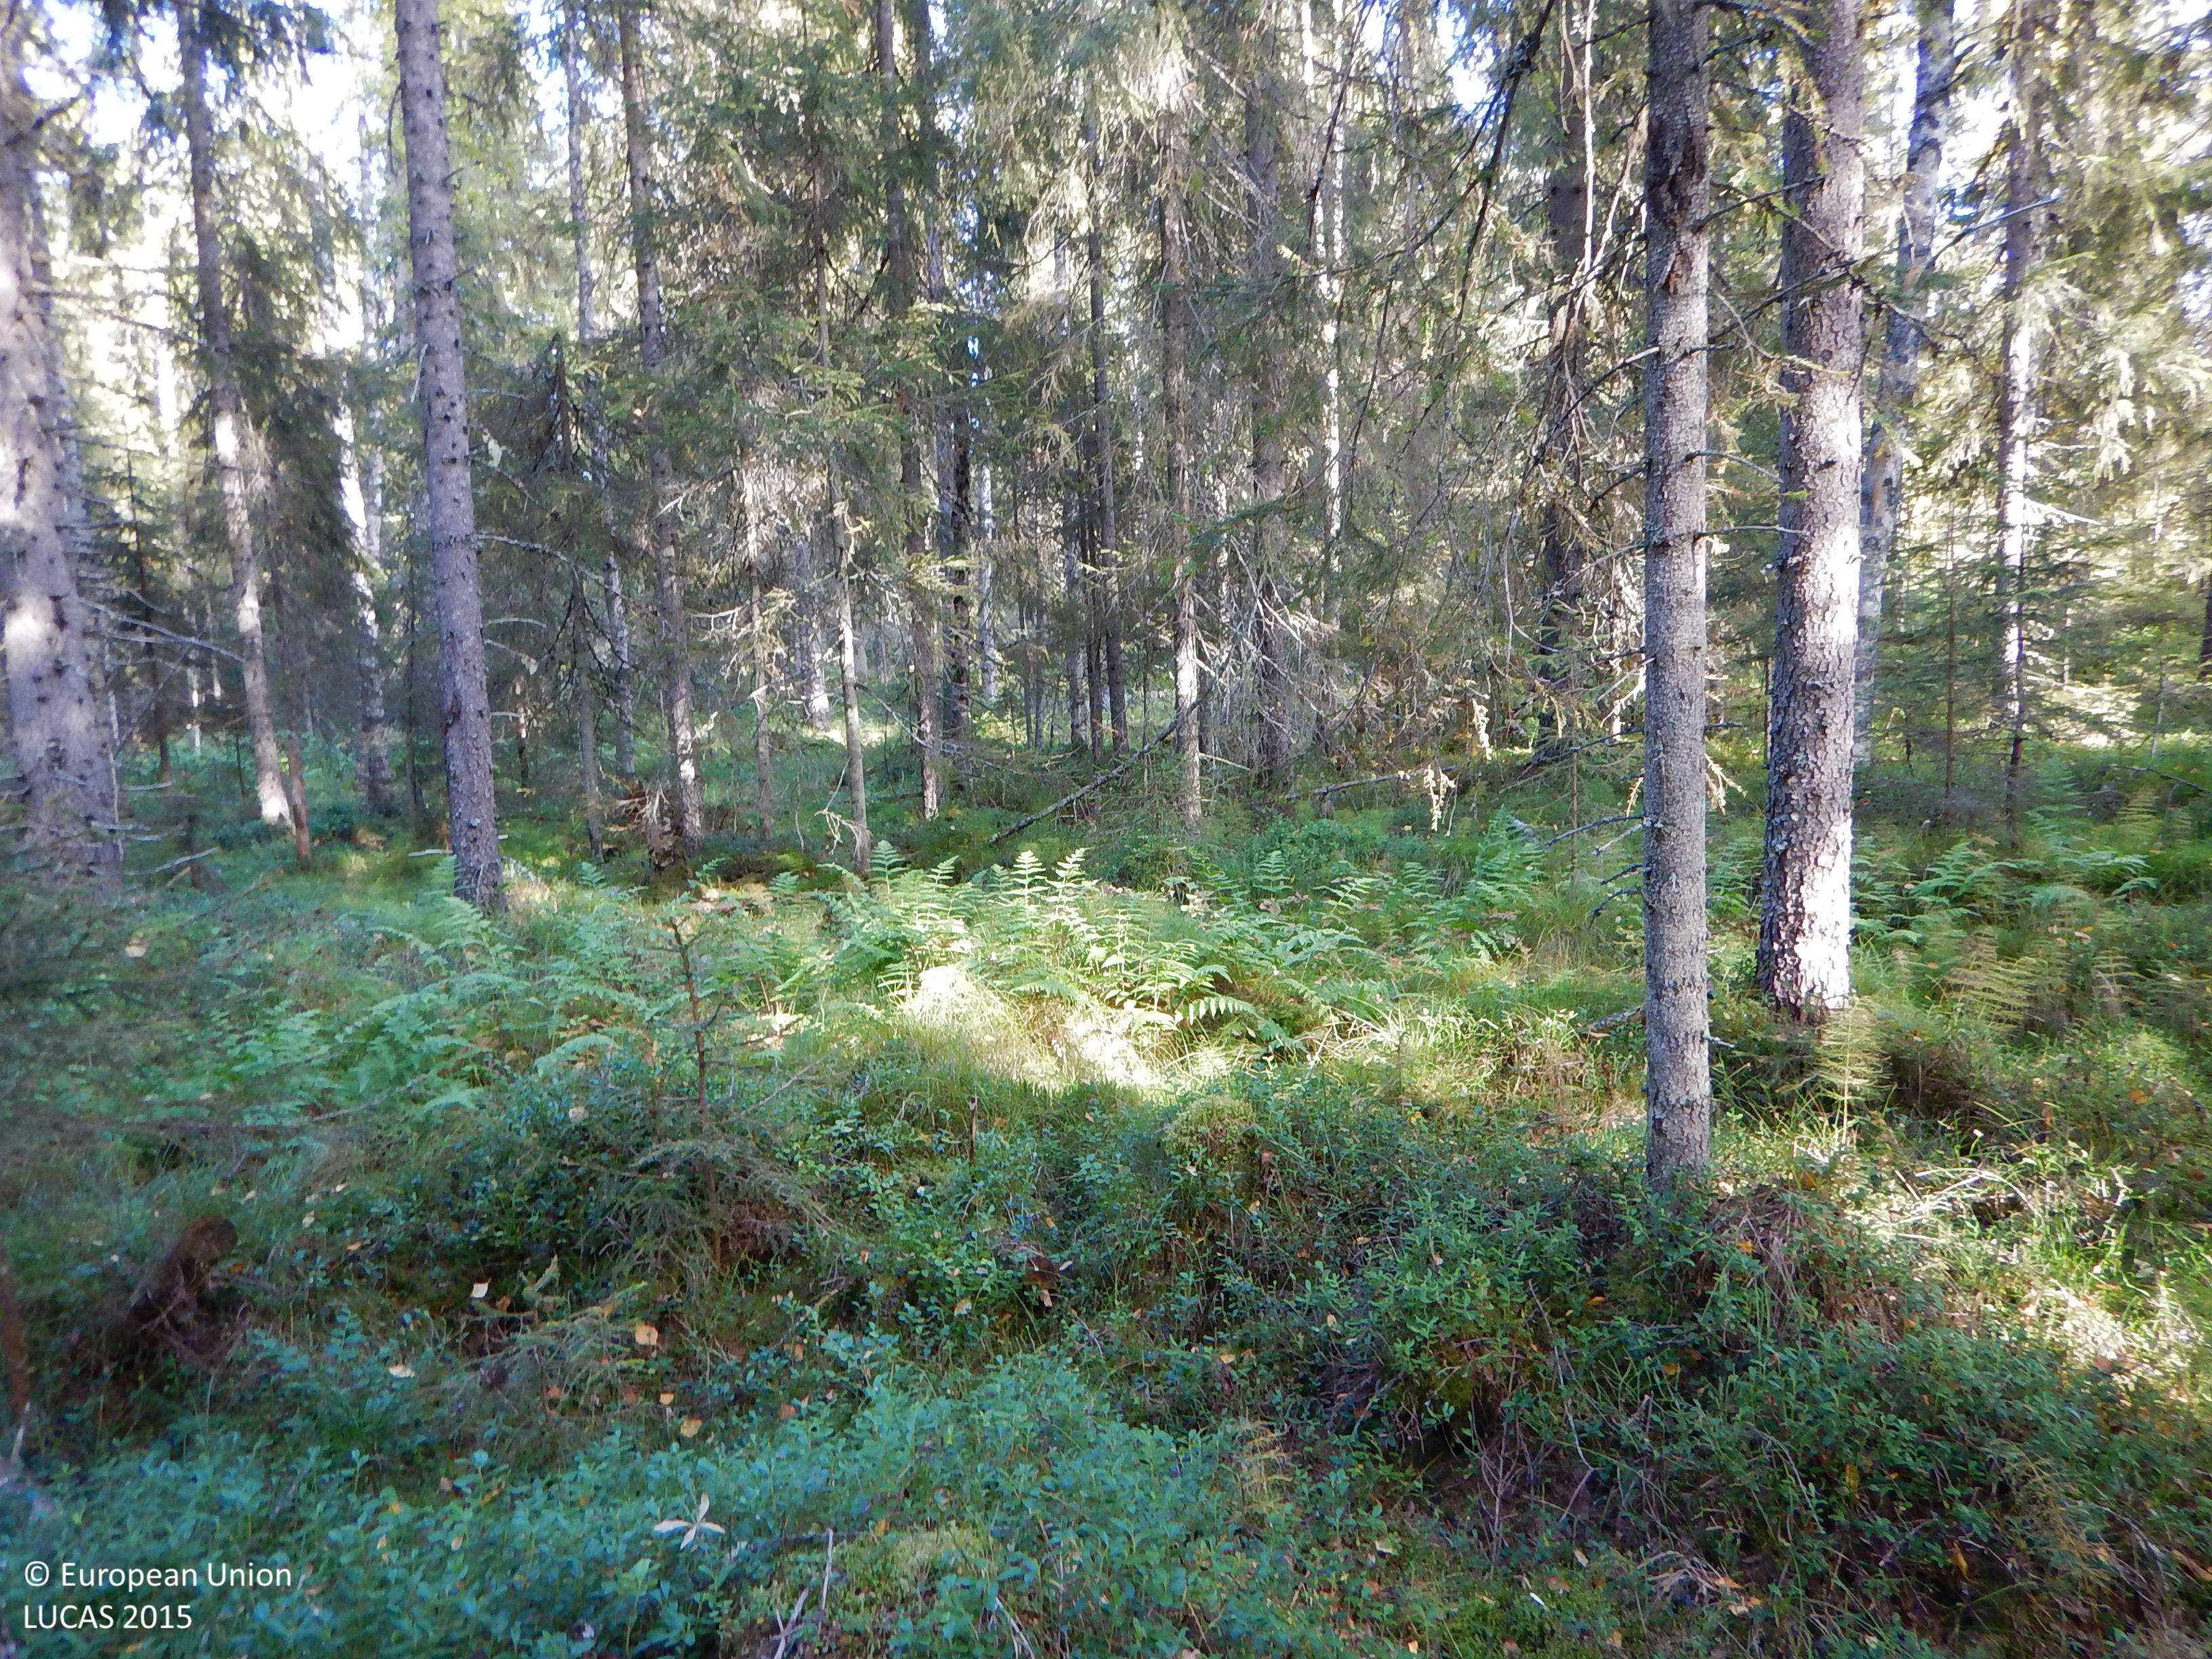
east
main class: Woodland
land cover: Spruce dominated coniferous woodland
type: boreal forest
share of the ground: 50 - 75 %
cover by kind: coniferous forest trees 50 %, shrubs 15 %, lichens and mosses 15 %, broadleaved forest trees 10 %, herbaceous plants 10 %
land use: Forestry
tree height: > 5 m
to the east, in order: Spruce dominated coniferous woodland; Tracks; Spruce dominated coniferous woodland; Tracks; Spruce dominated coniferous woodland; Tracks; Spruce dominated coniferous woodland; Spruce dominated mixed woodland; Grass margins; Paved roads, cycling and walking lanes; Grass margins; Ditches and canals; Other coniferous woodland
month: September
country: SE
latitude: 64.6955
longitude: 20.1005
